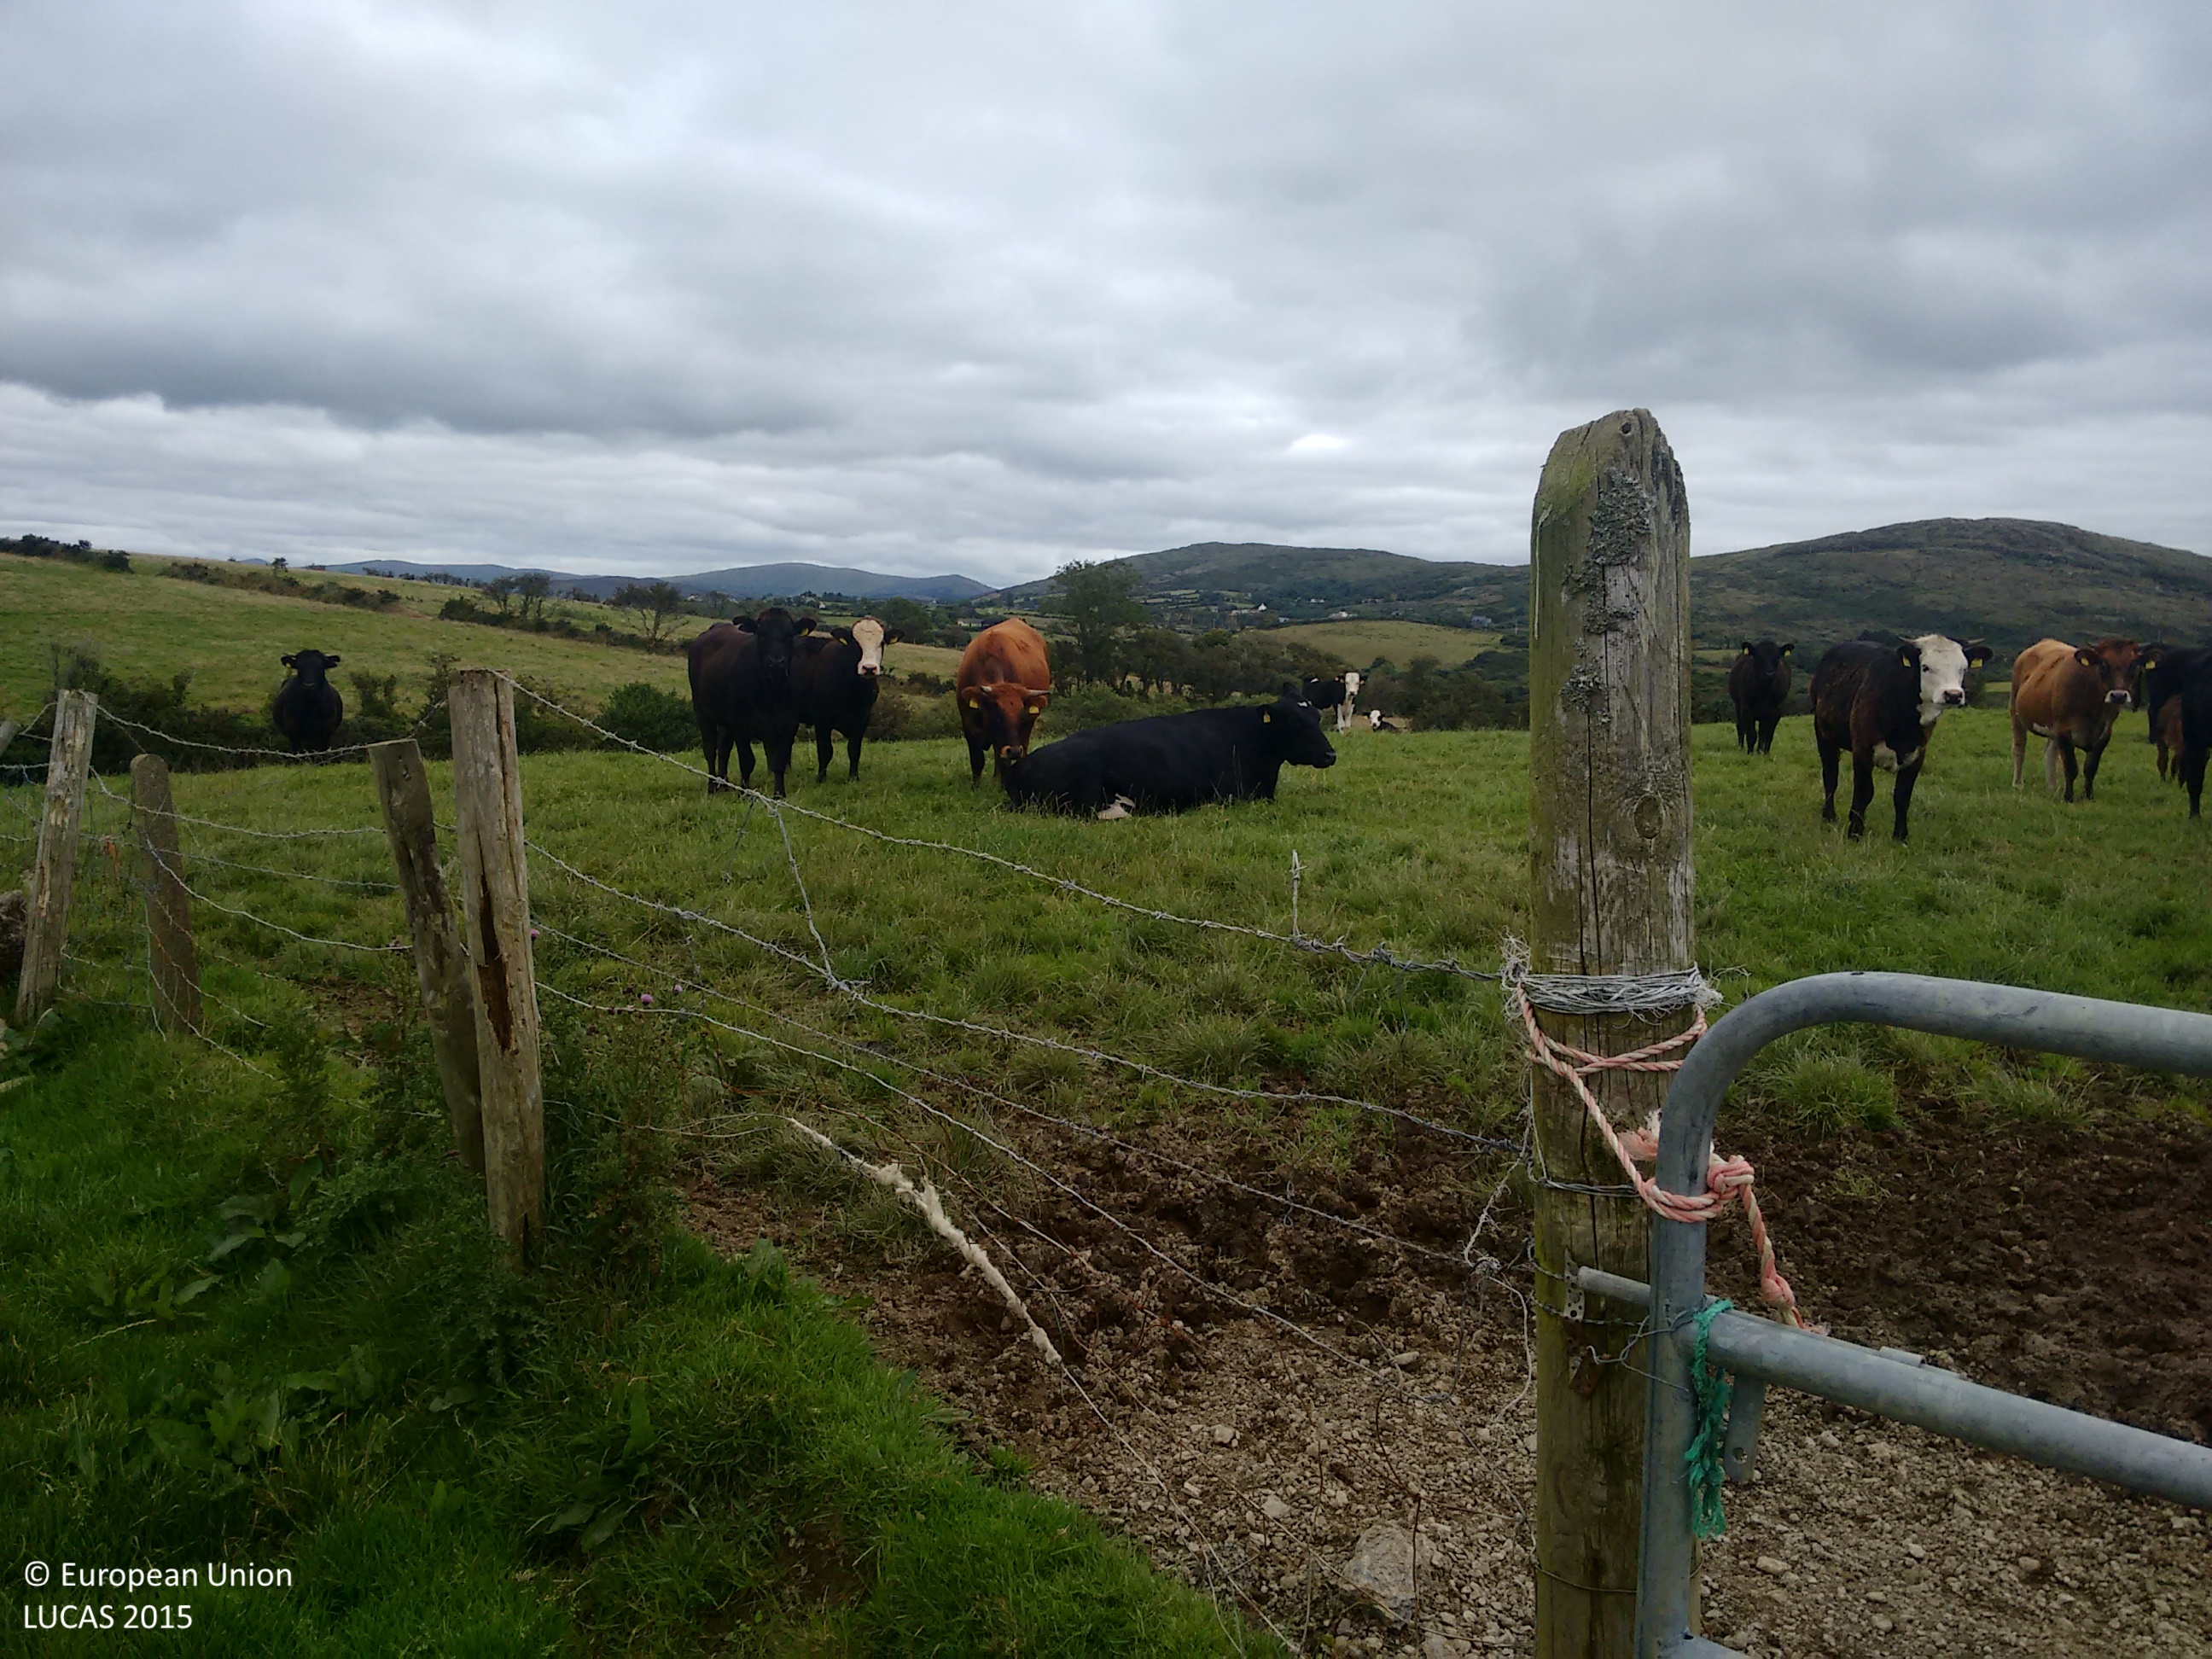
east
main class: Grassland
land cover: Grassland without tree/shrub cover
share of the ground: > 75 %
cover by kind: herbaceous plants 100 %
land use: Agriculture (excluding fallow land and kitchen gardens)
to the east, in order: Grassland without tree/shrub cover; Fences; Abandoned hedges; Grassland without tree/shrub cover; Broadleaved woodland
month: August
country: IE
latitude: 51.6669
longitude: -9.4761
